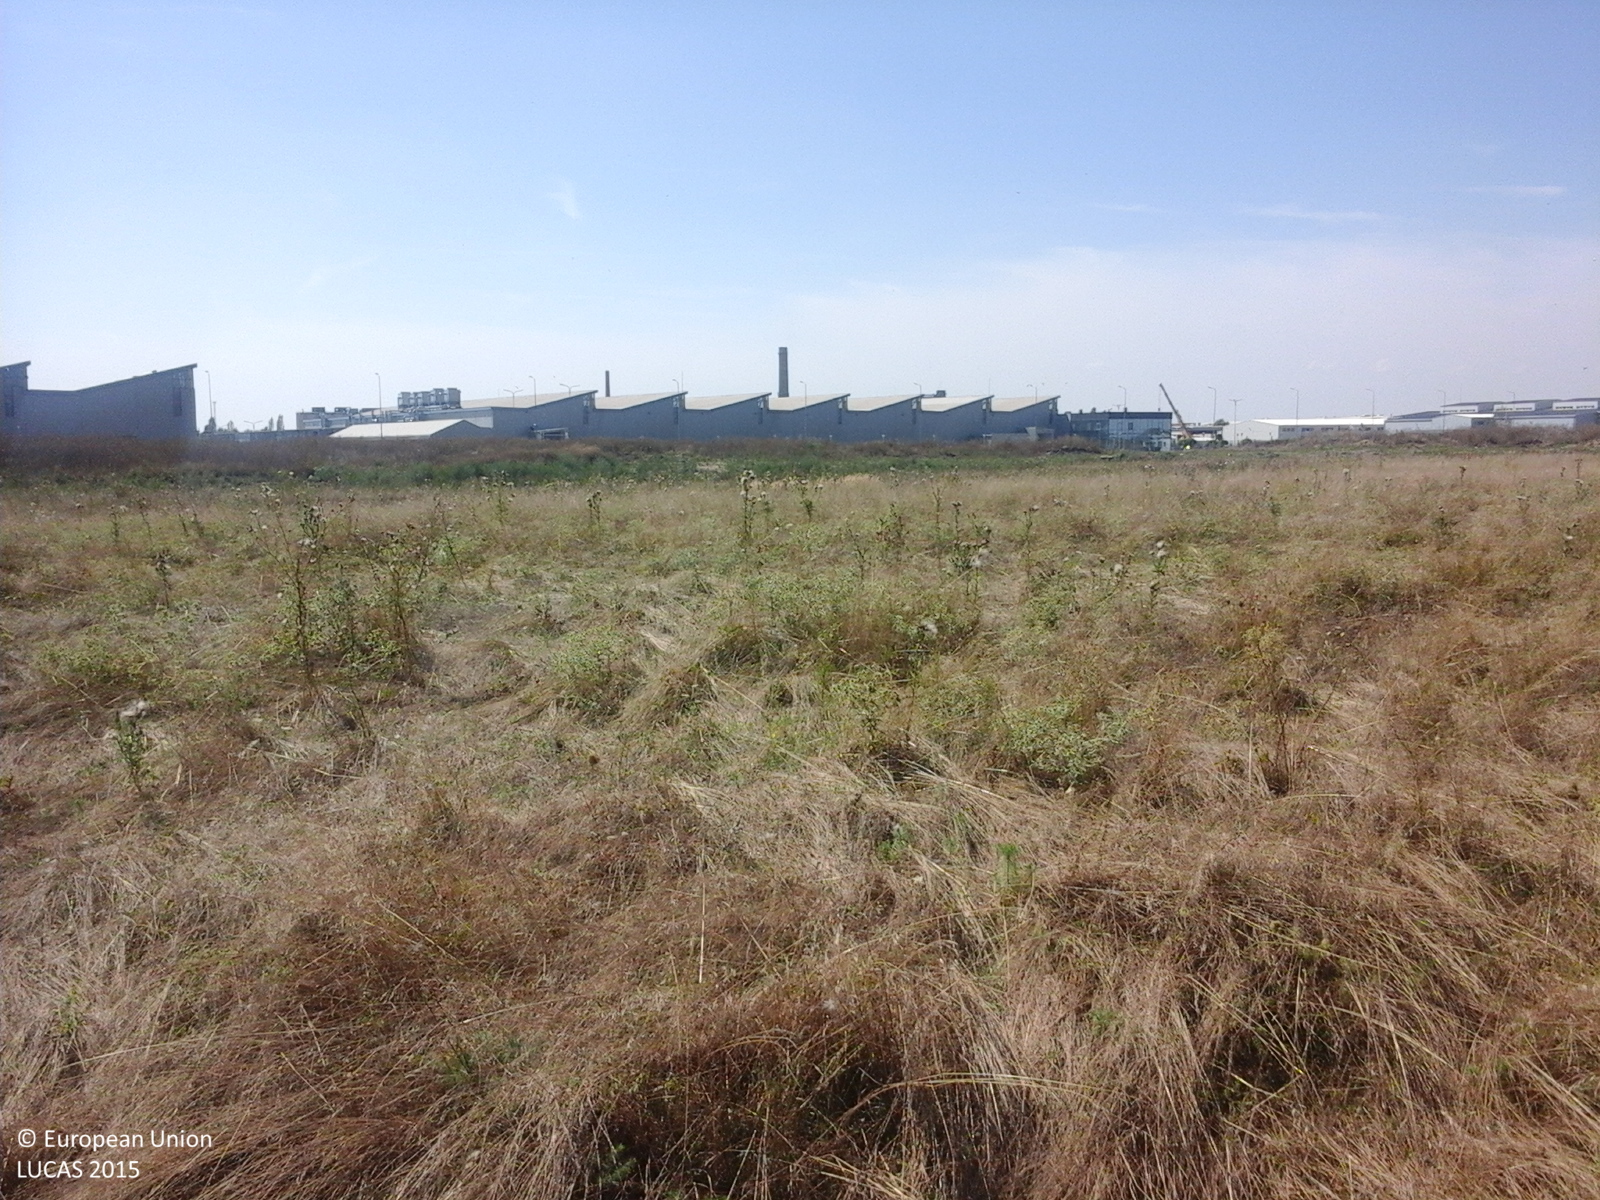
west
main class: Grassland
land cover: Spontaneously vegetated surfaces
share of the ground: > 75 %
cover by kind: herbaceous plants 100 %
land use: Fallow land
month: August
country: RO
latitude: 45.7278
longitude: 21.1703
